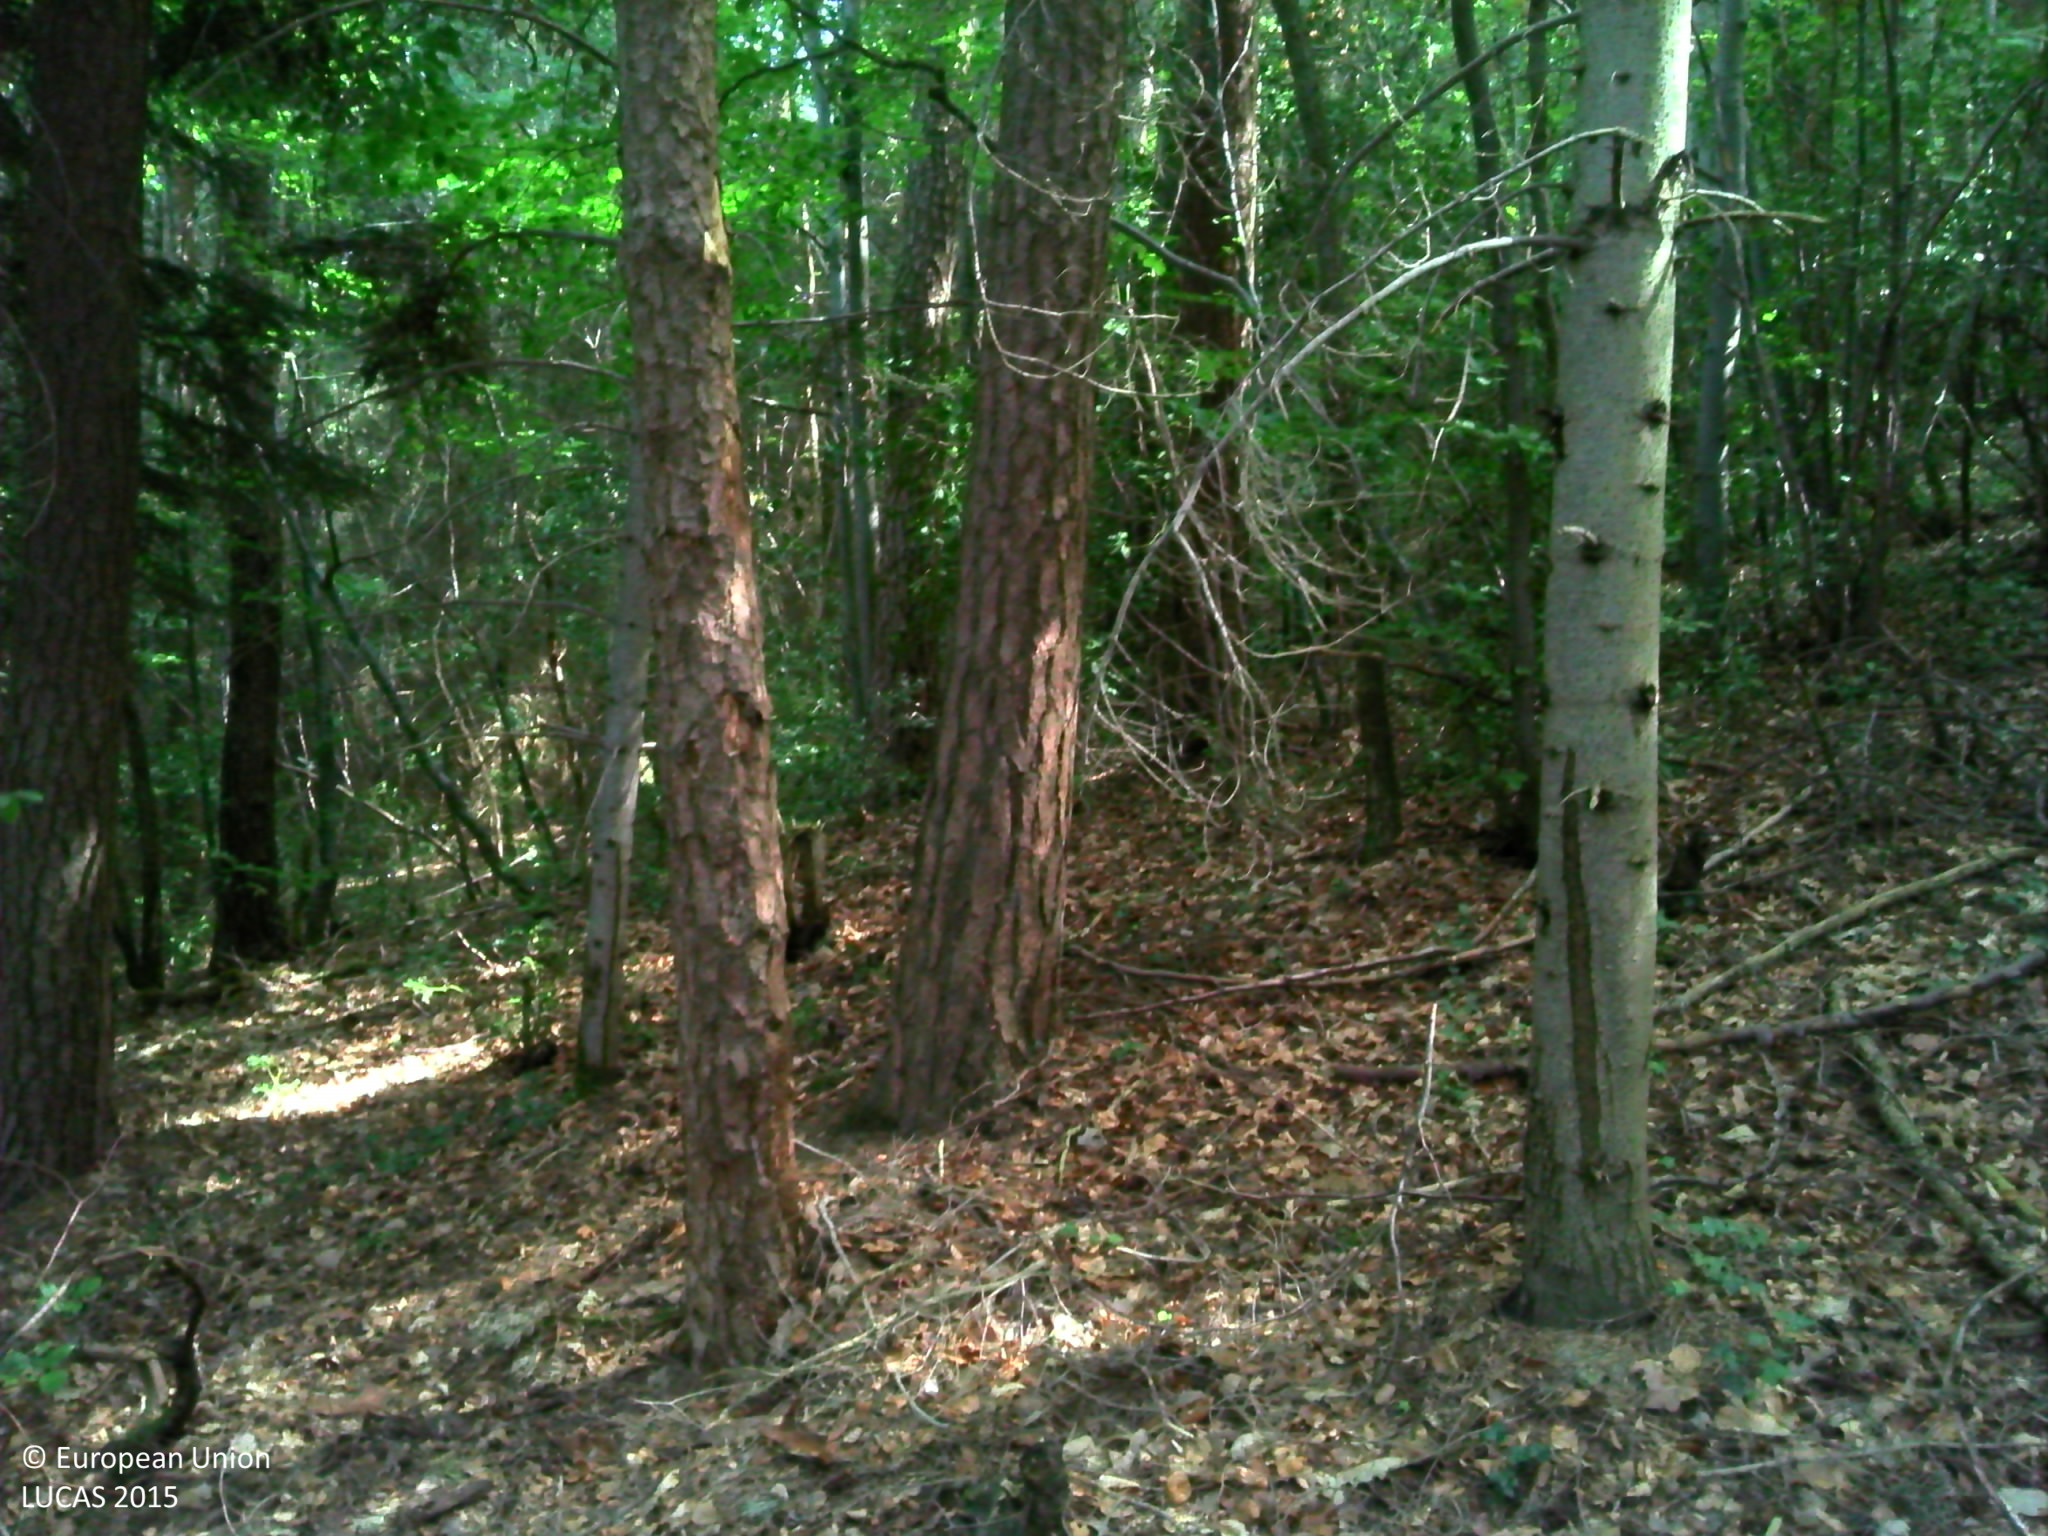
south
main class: Woodland
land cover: Spruce dominated coniferous woodland
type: hemiboreal forest and nemoral coniferous forest and mixed broadleaved-coniferous forest
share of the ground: > 75 %
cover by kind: coniferous forest trees 95 %, unconsolidated bare surface 5 %
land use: Forestry
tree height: > 5 m
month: July
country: FR
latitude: 45.1712
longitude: 3.1183
